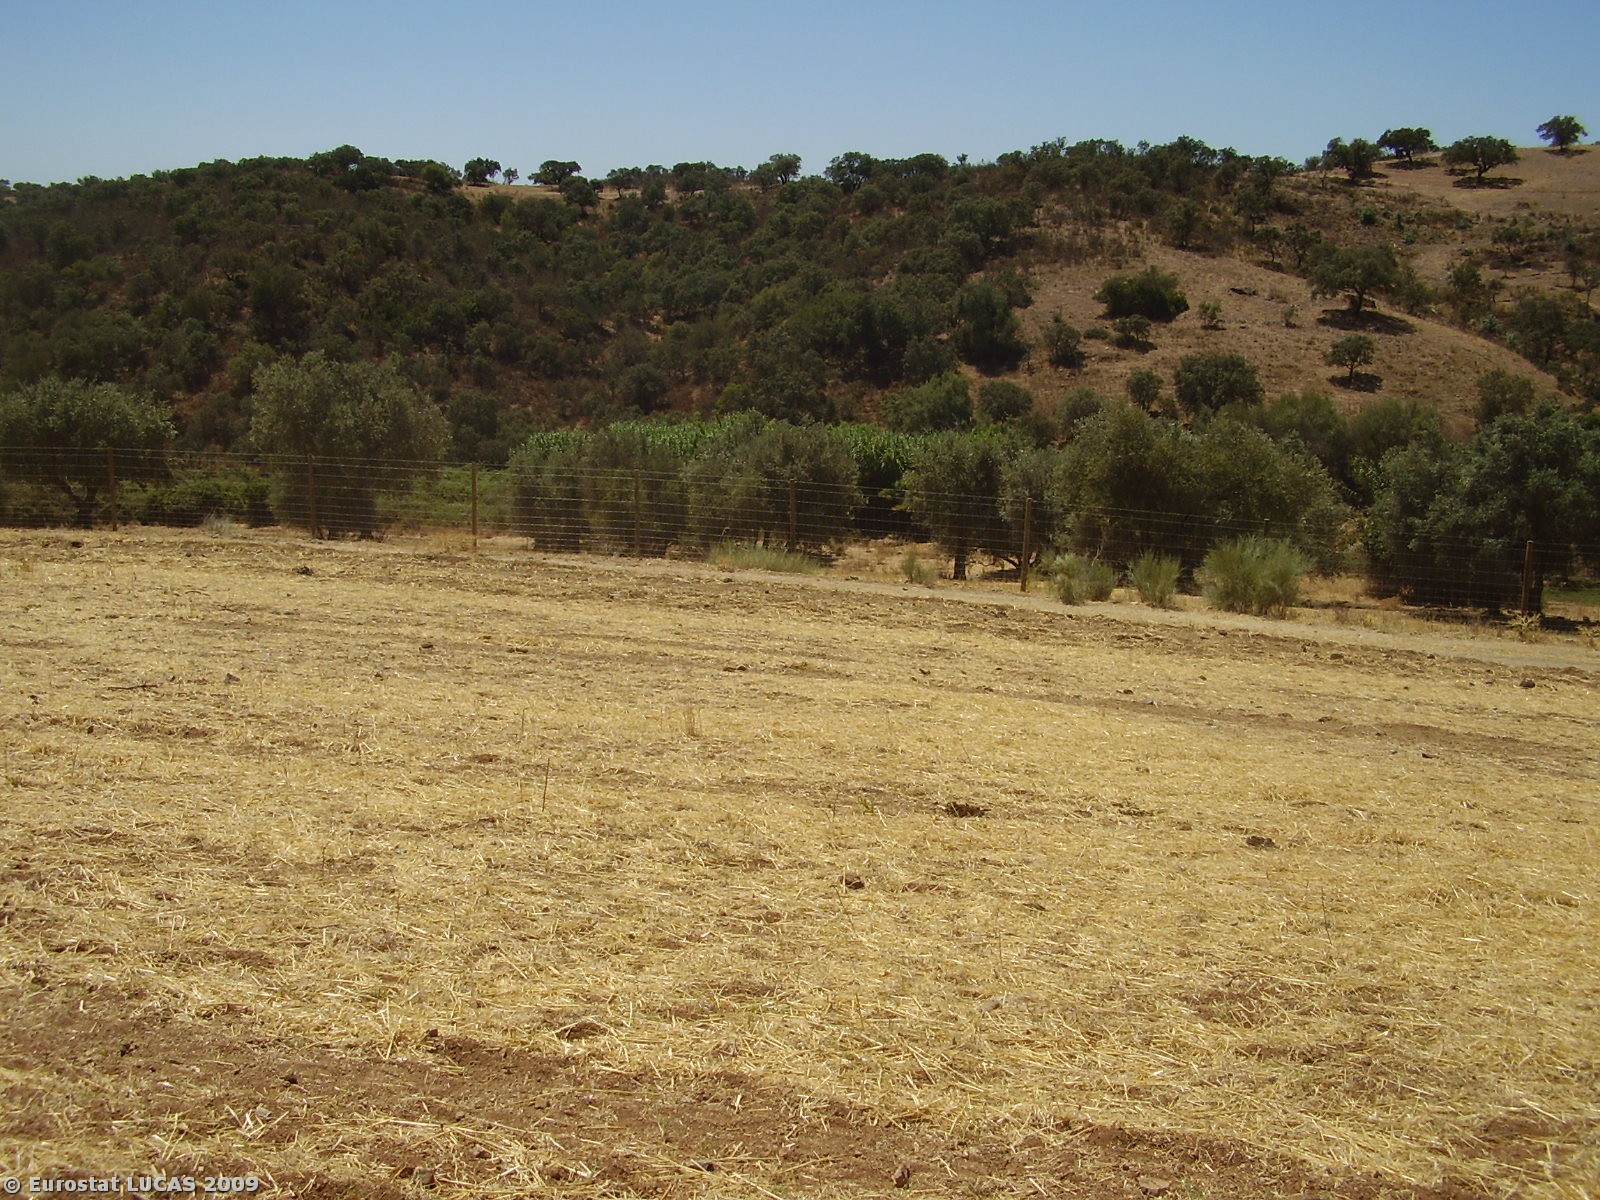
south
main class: Cropland
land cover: Common wheat
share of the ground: < 10 %
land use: Agriculture (excluding fallow land and kitchen gardens)
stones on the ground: 25 - 50 %
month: August
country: PT
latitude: 37.9113
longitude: -7.6625
